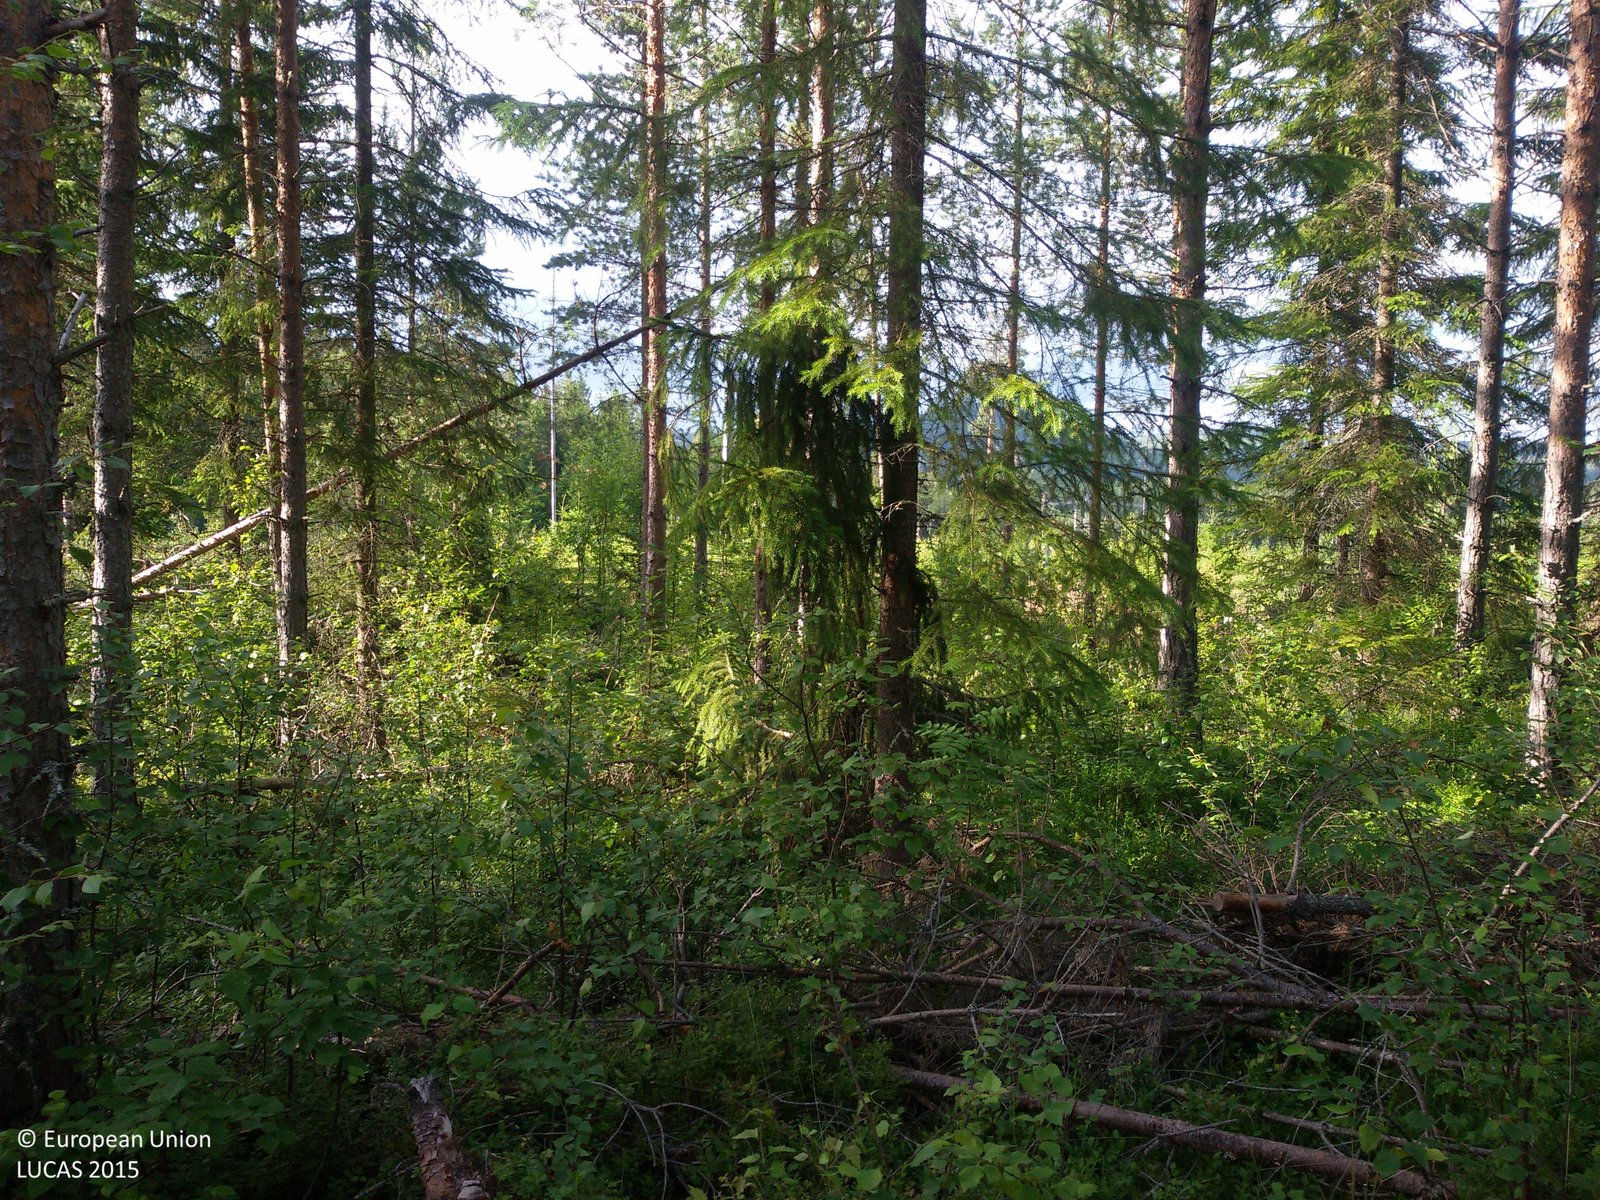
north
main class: Woodland
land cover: Pine dominated coniferous woodland
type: boreal forest
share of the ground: 50 - 75 %
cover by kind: coniferous forest trees 50 %, shrubs 30 %, broadleaved forest trees 10 %, lichens and mosses 10 %
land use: Forestry
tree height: > 5 m
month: July
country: SE
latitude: 60.5147
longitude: 15.2879
